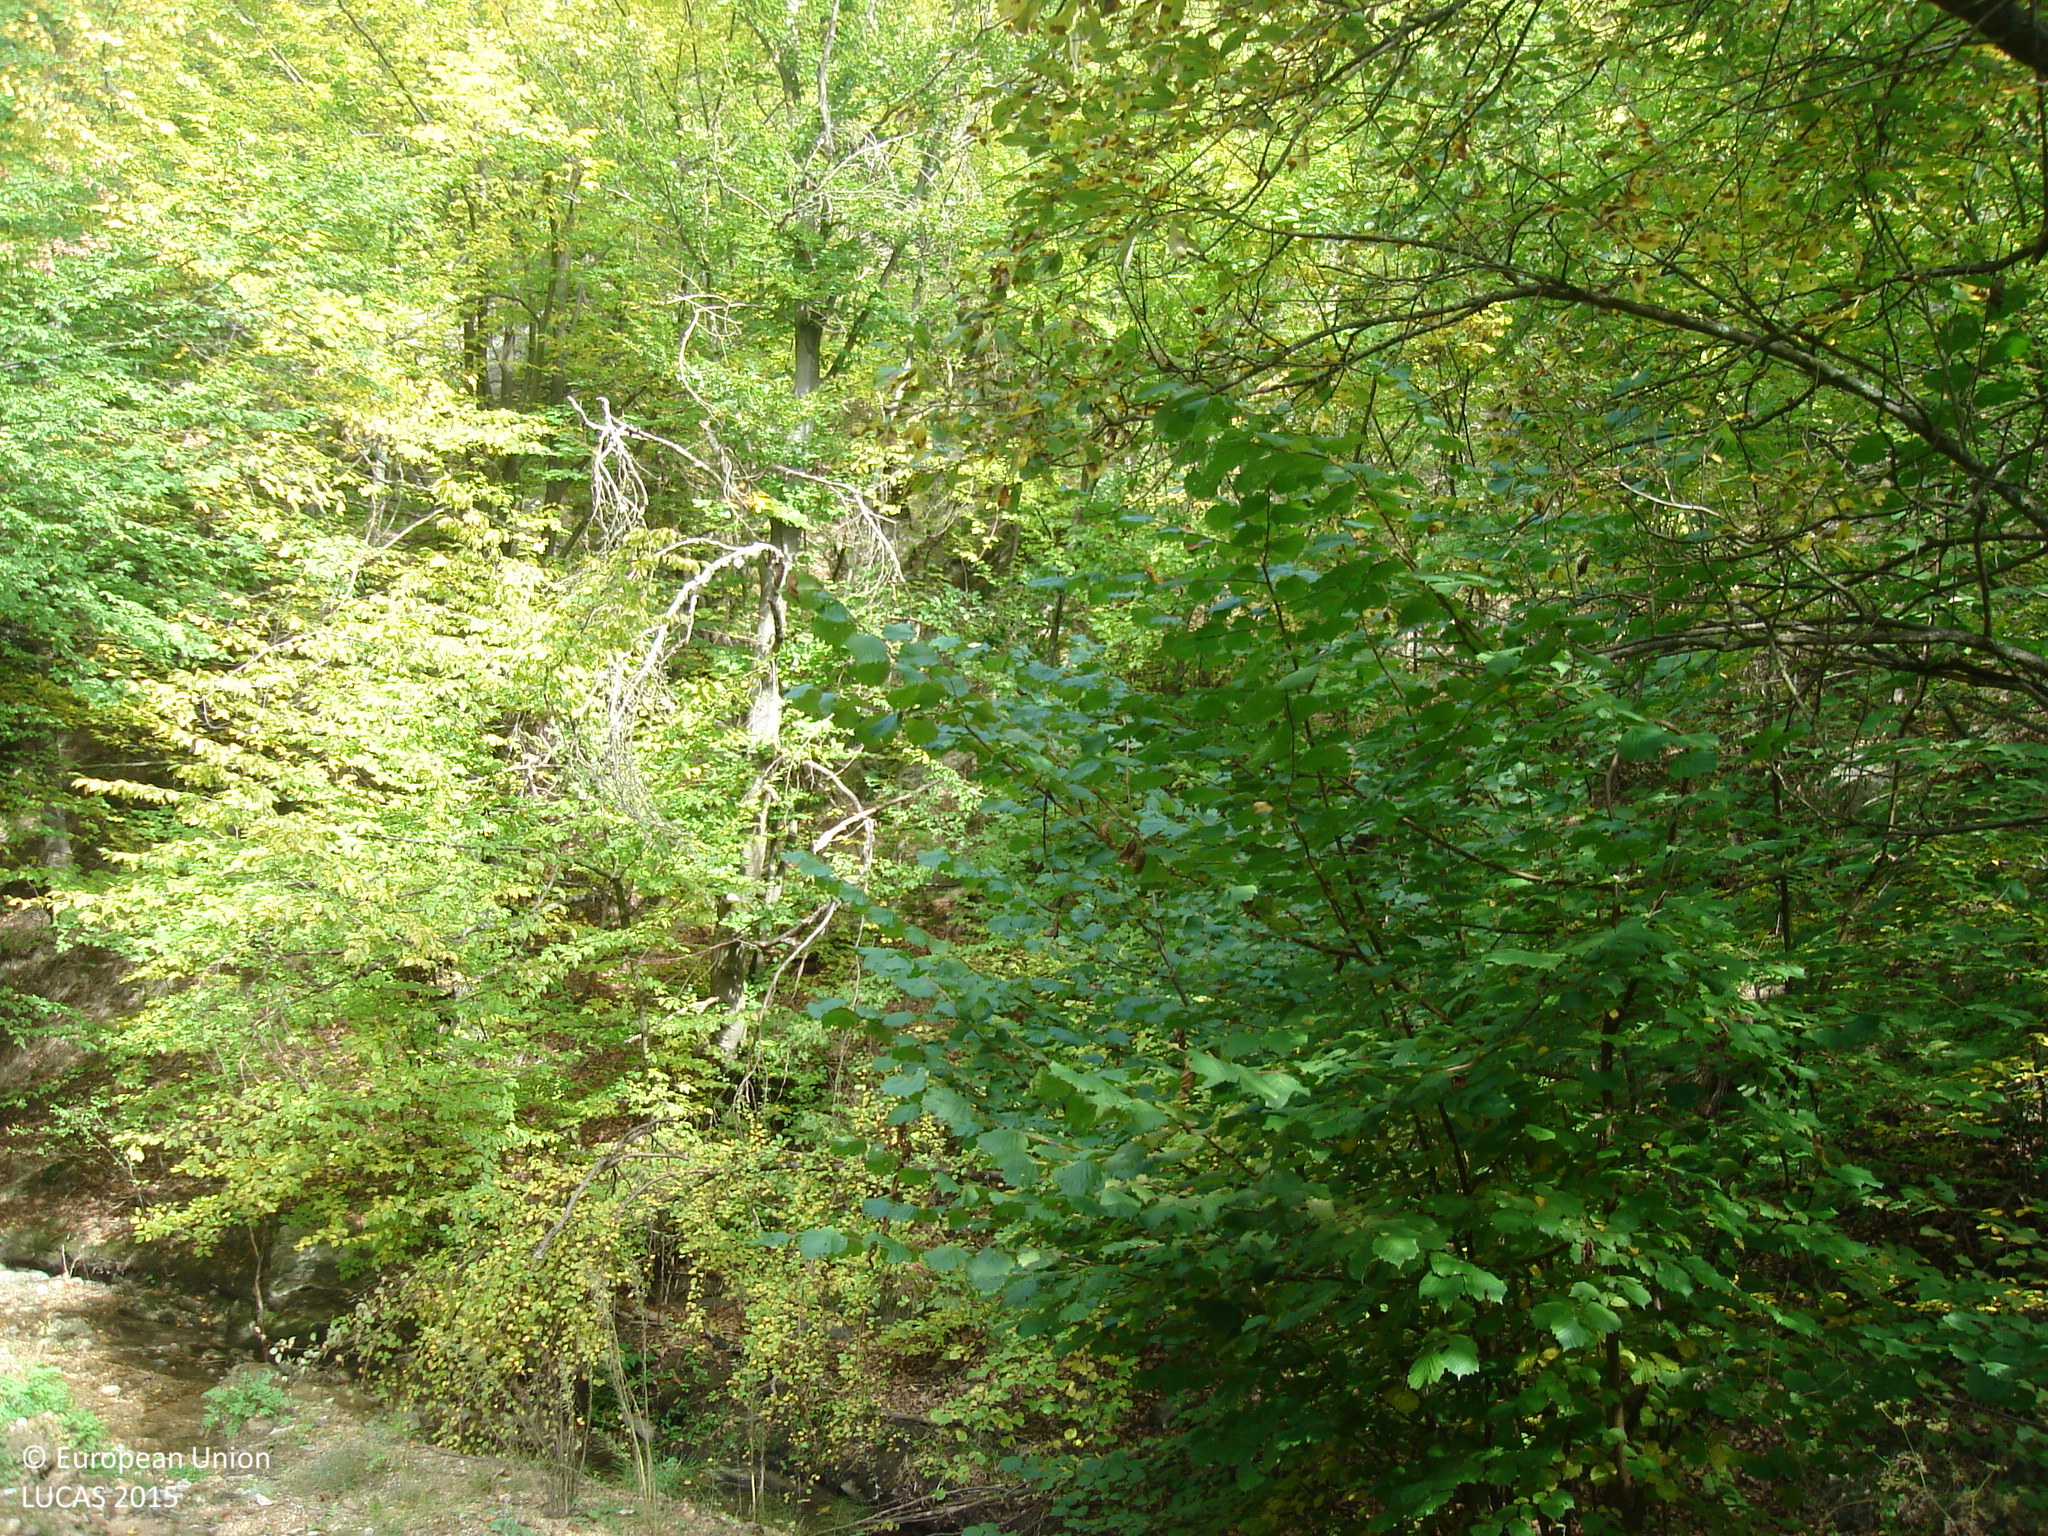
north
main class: Woodland
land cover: Broadleaved woodland
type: mesophytic deciduous forest
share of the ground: > 75 %
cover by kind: broadleaved forest trees 100 %
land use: Forestry
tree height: > 5 m
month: October
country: BG
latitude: 42.5795
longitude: 23.8207
